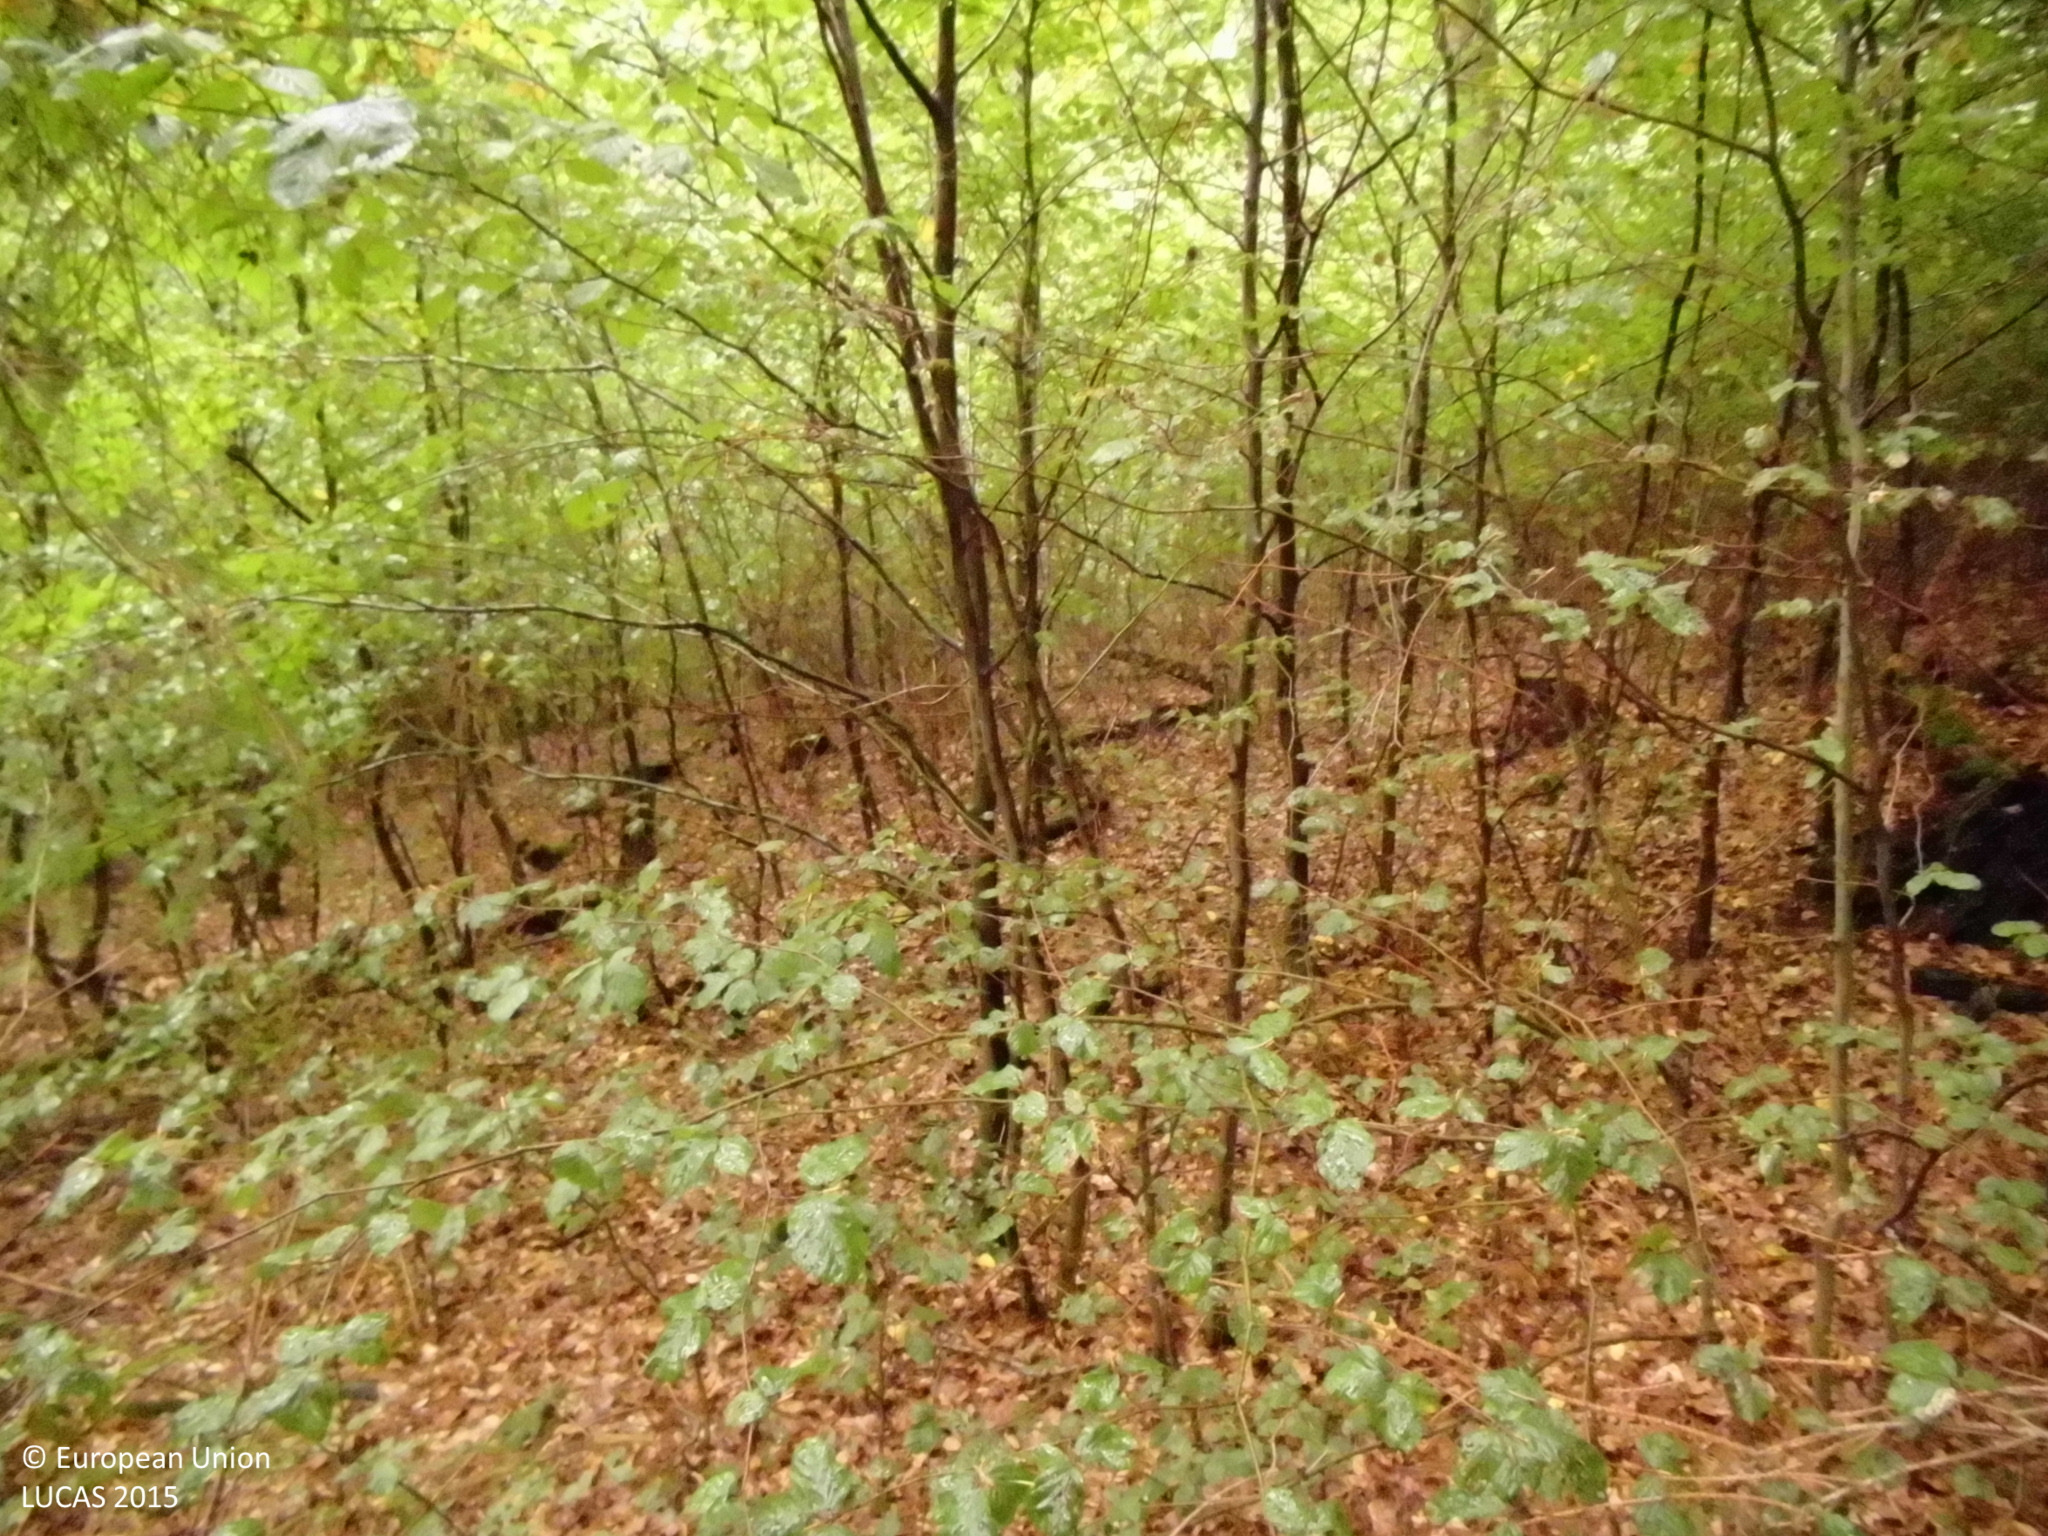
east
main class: Woodland
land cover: Broadleaved woodland
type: mesophytic deciduous forest
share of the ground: > 75 %
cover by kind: broadleaved forest trees 100 %
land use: Forestry
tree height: > 5 m
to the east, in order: Broadleaved woodland; Tracks; Shruby margins; Broadleaved woodland; Shruby margins; Tracks; Spruce dominated mixed woodland; Broadleaved woodland; Spruce dominated coniferous woodland; Pine dominated mixed woodland; Spruce dominated coniferous woodland
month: September
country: DE
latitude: 50.6239
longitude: 7.4700
